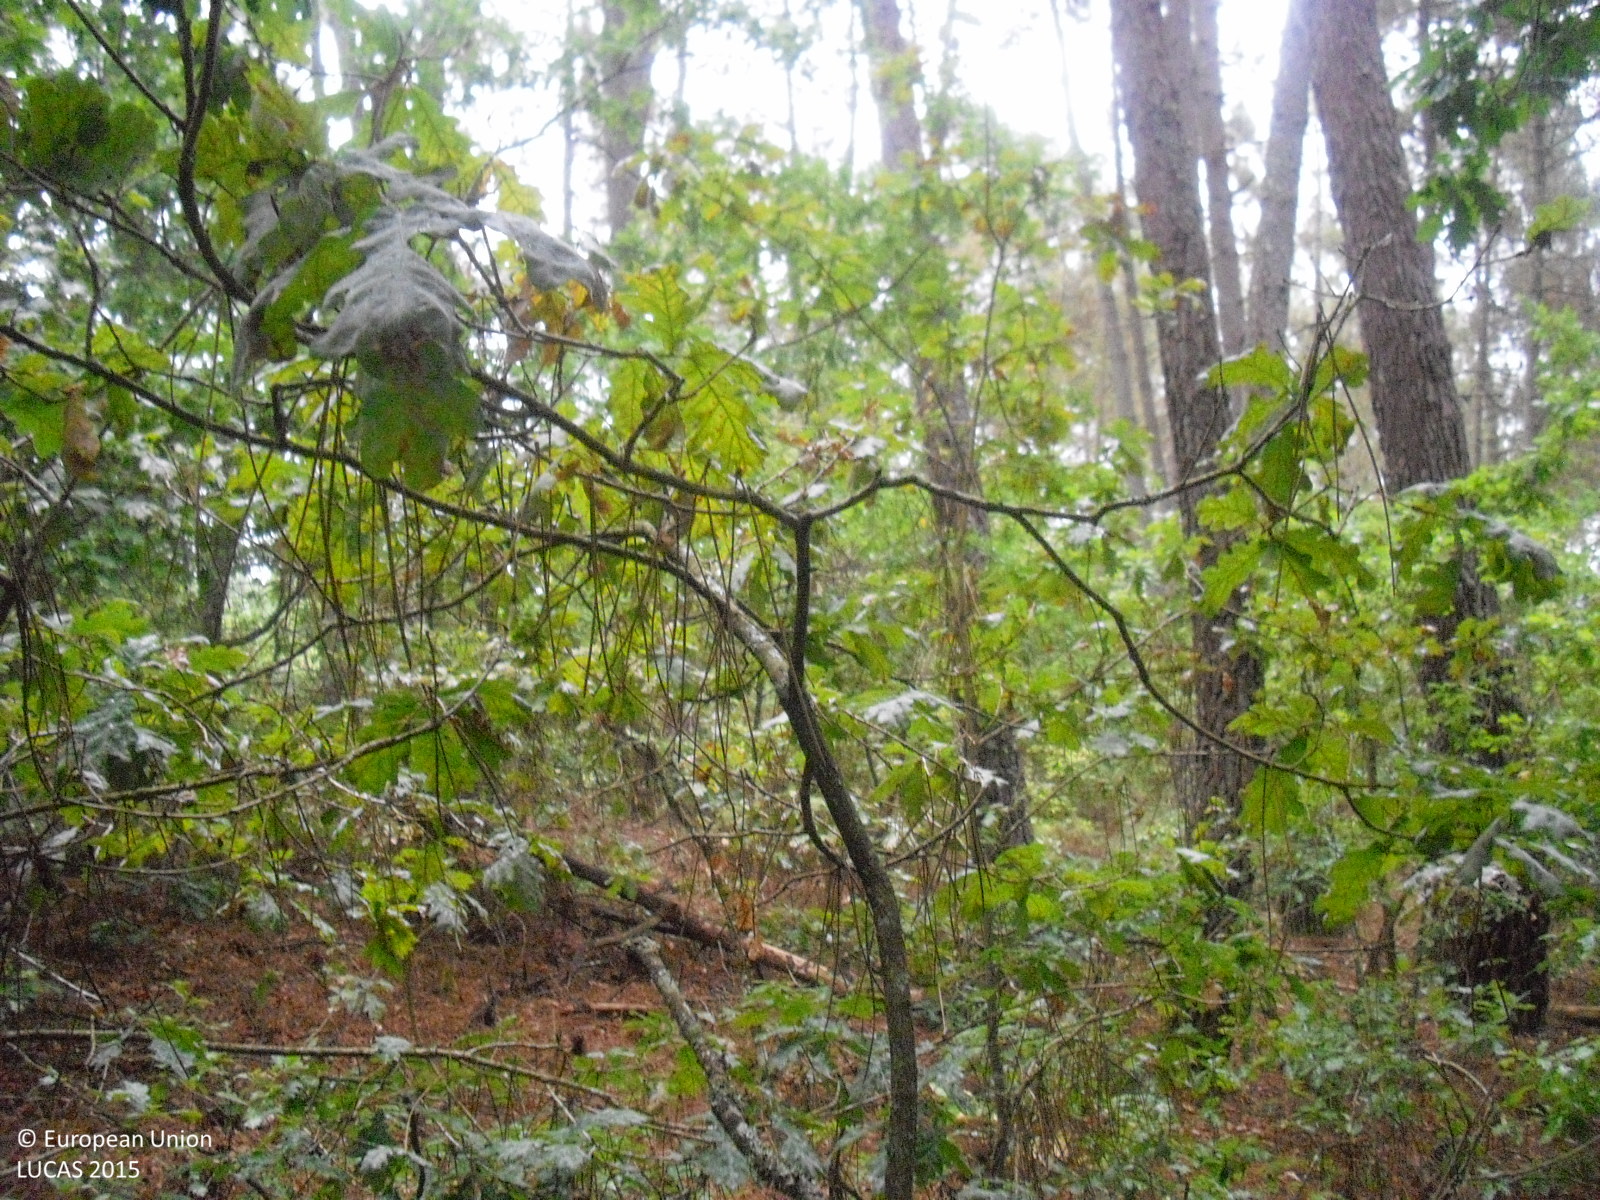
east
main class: Woodland
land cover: Pine dominated mixed woodland
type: hemiboreal forest and nemoral coniferous forest and mixed broadleaved-coniferous forest
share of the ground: > 75 %
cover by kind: coniferous forest trees 60 %, broadleaved forest trees 20 %, shrubs 20 %
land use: Forestry
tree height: > 5 m
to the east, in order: Pine dominated mixed woodland; Tracks; Broadleaved woodland; Ditches and canals; Broadleaved woodland; Rivers and streams; Broadleaved woodland; Shruby margins; Tracks; Shruby margins; Other bare soil; Shruby margins; Tracks; Ditches and canals; Pine dominated mixed woodland
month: July
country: ES
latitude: 42.3026
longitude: -7.6725
